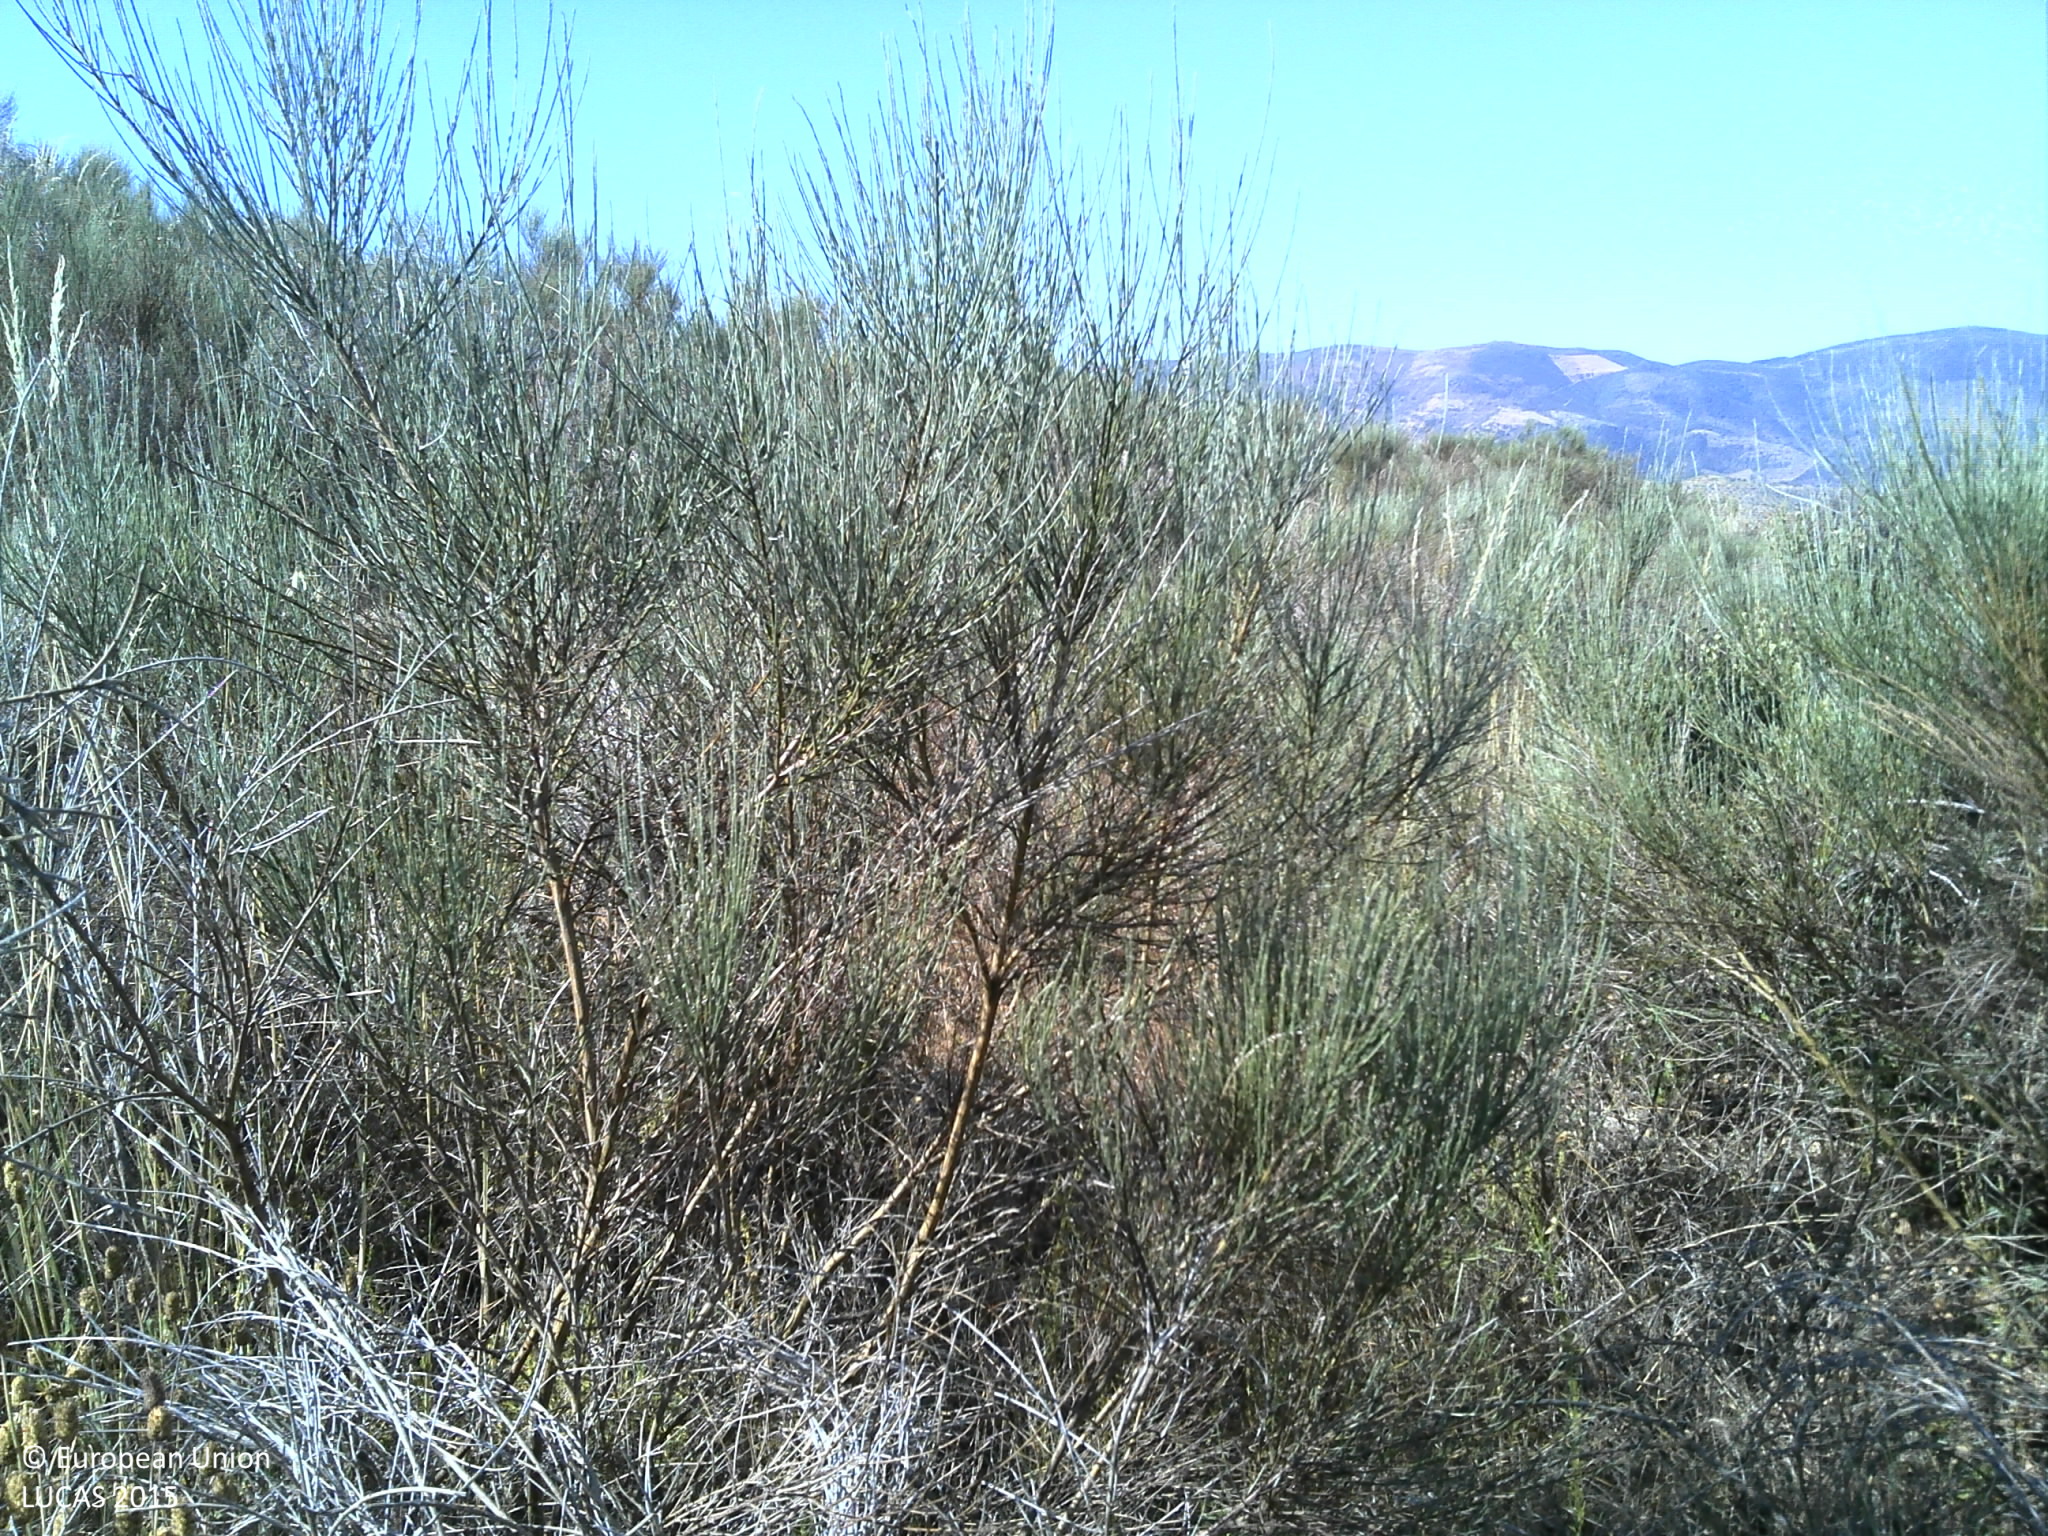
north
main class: Shrubland
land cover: Shrubland without tree cover
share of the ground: > 75 %
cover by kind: shrubs 95 %, herbaceous plants 5 %
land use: Semi-natural and natural areas not in use
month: June
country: PT
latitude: 40.9977
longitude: -7.0241
